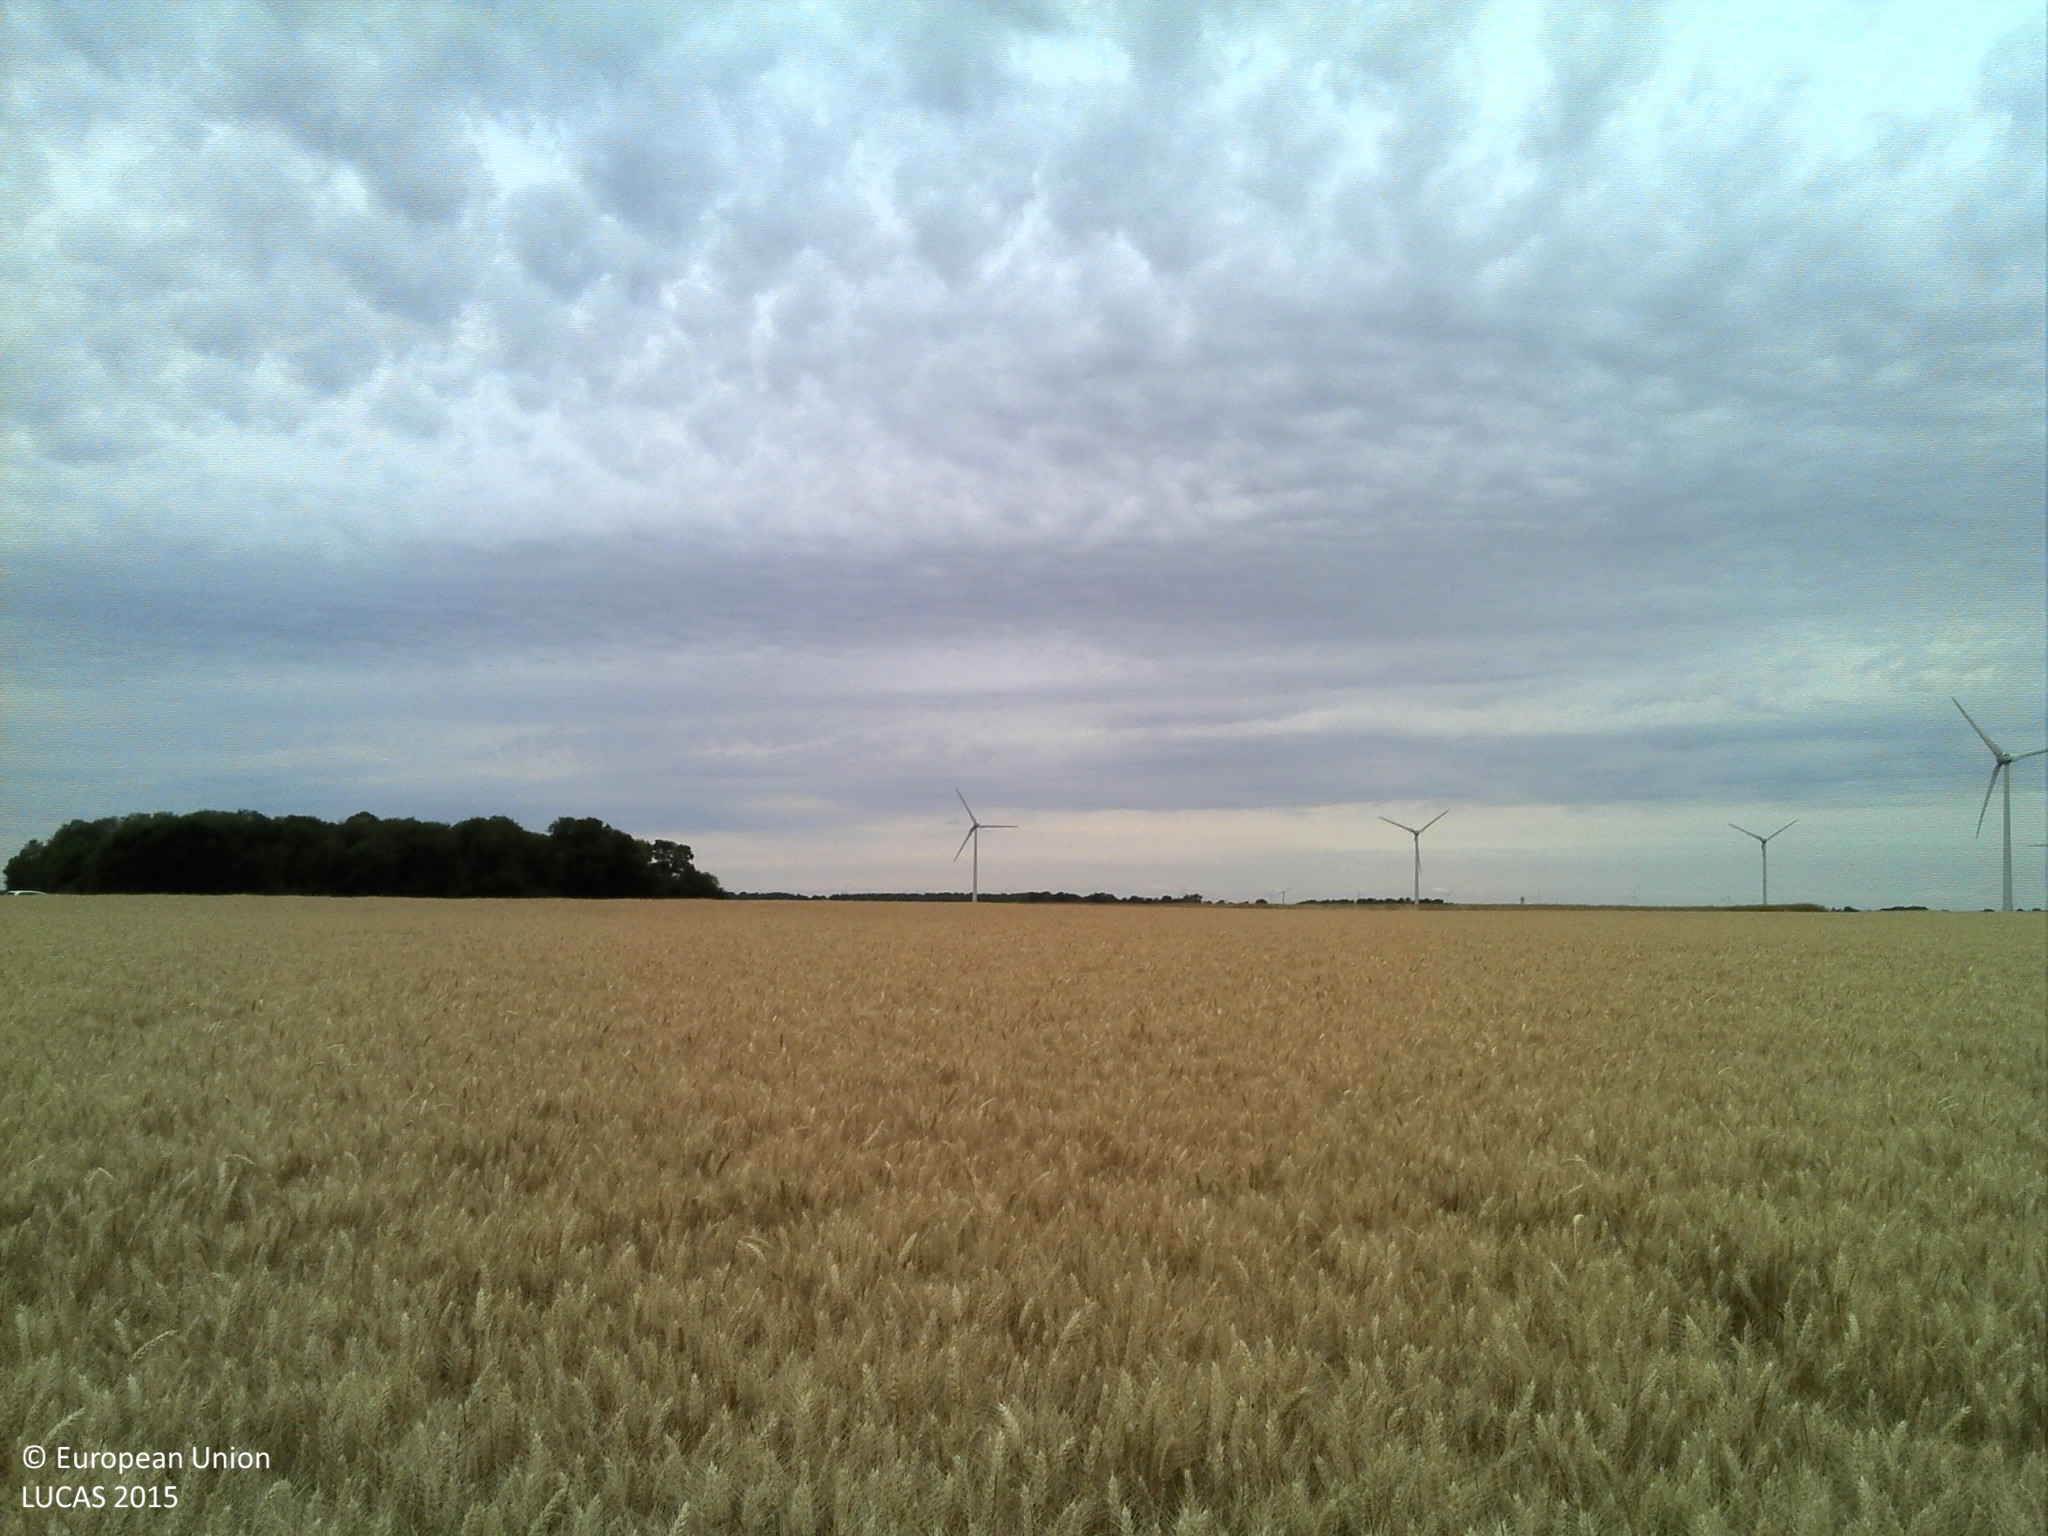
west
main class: Cropland
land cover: Durum wheat
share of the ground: > 75 %
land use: Agriculture (excluding fallow land and kitchen gardens)
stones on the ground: < 10 %
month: July
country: FR
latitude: 48.3294
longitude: 1.9881
